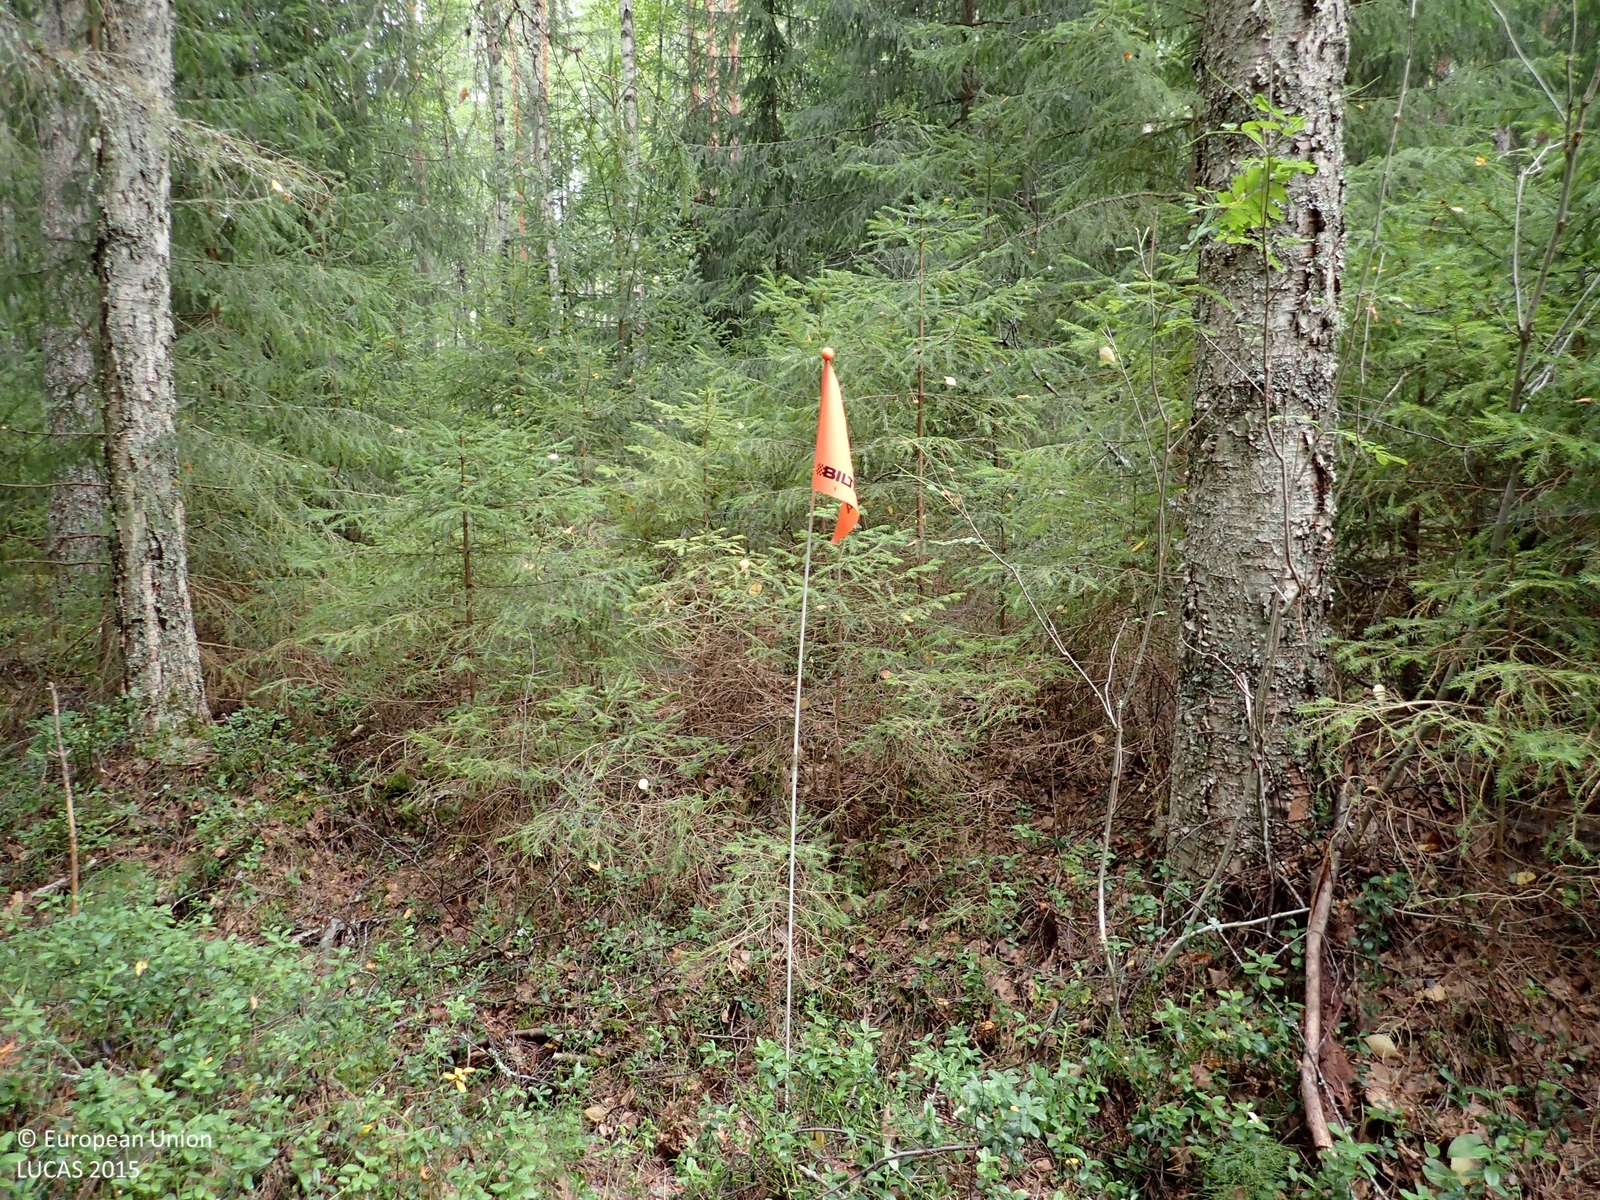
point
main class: Woodland
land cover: Other coniferous woodland
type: boreal forest
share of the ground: > 75 %
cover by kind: coniferous forest trees 70 %, shrubs 15 %, broadleaved forest trees 10 %, lichens and mosses 5 %
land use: Forestry
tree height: > 5 m
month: August
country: FI
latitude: 62.6656
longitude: 22.6078
